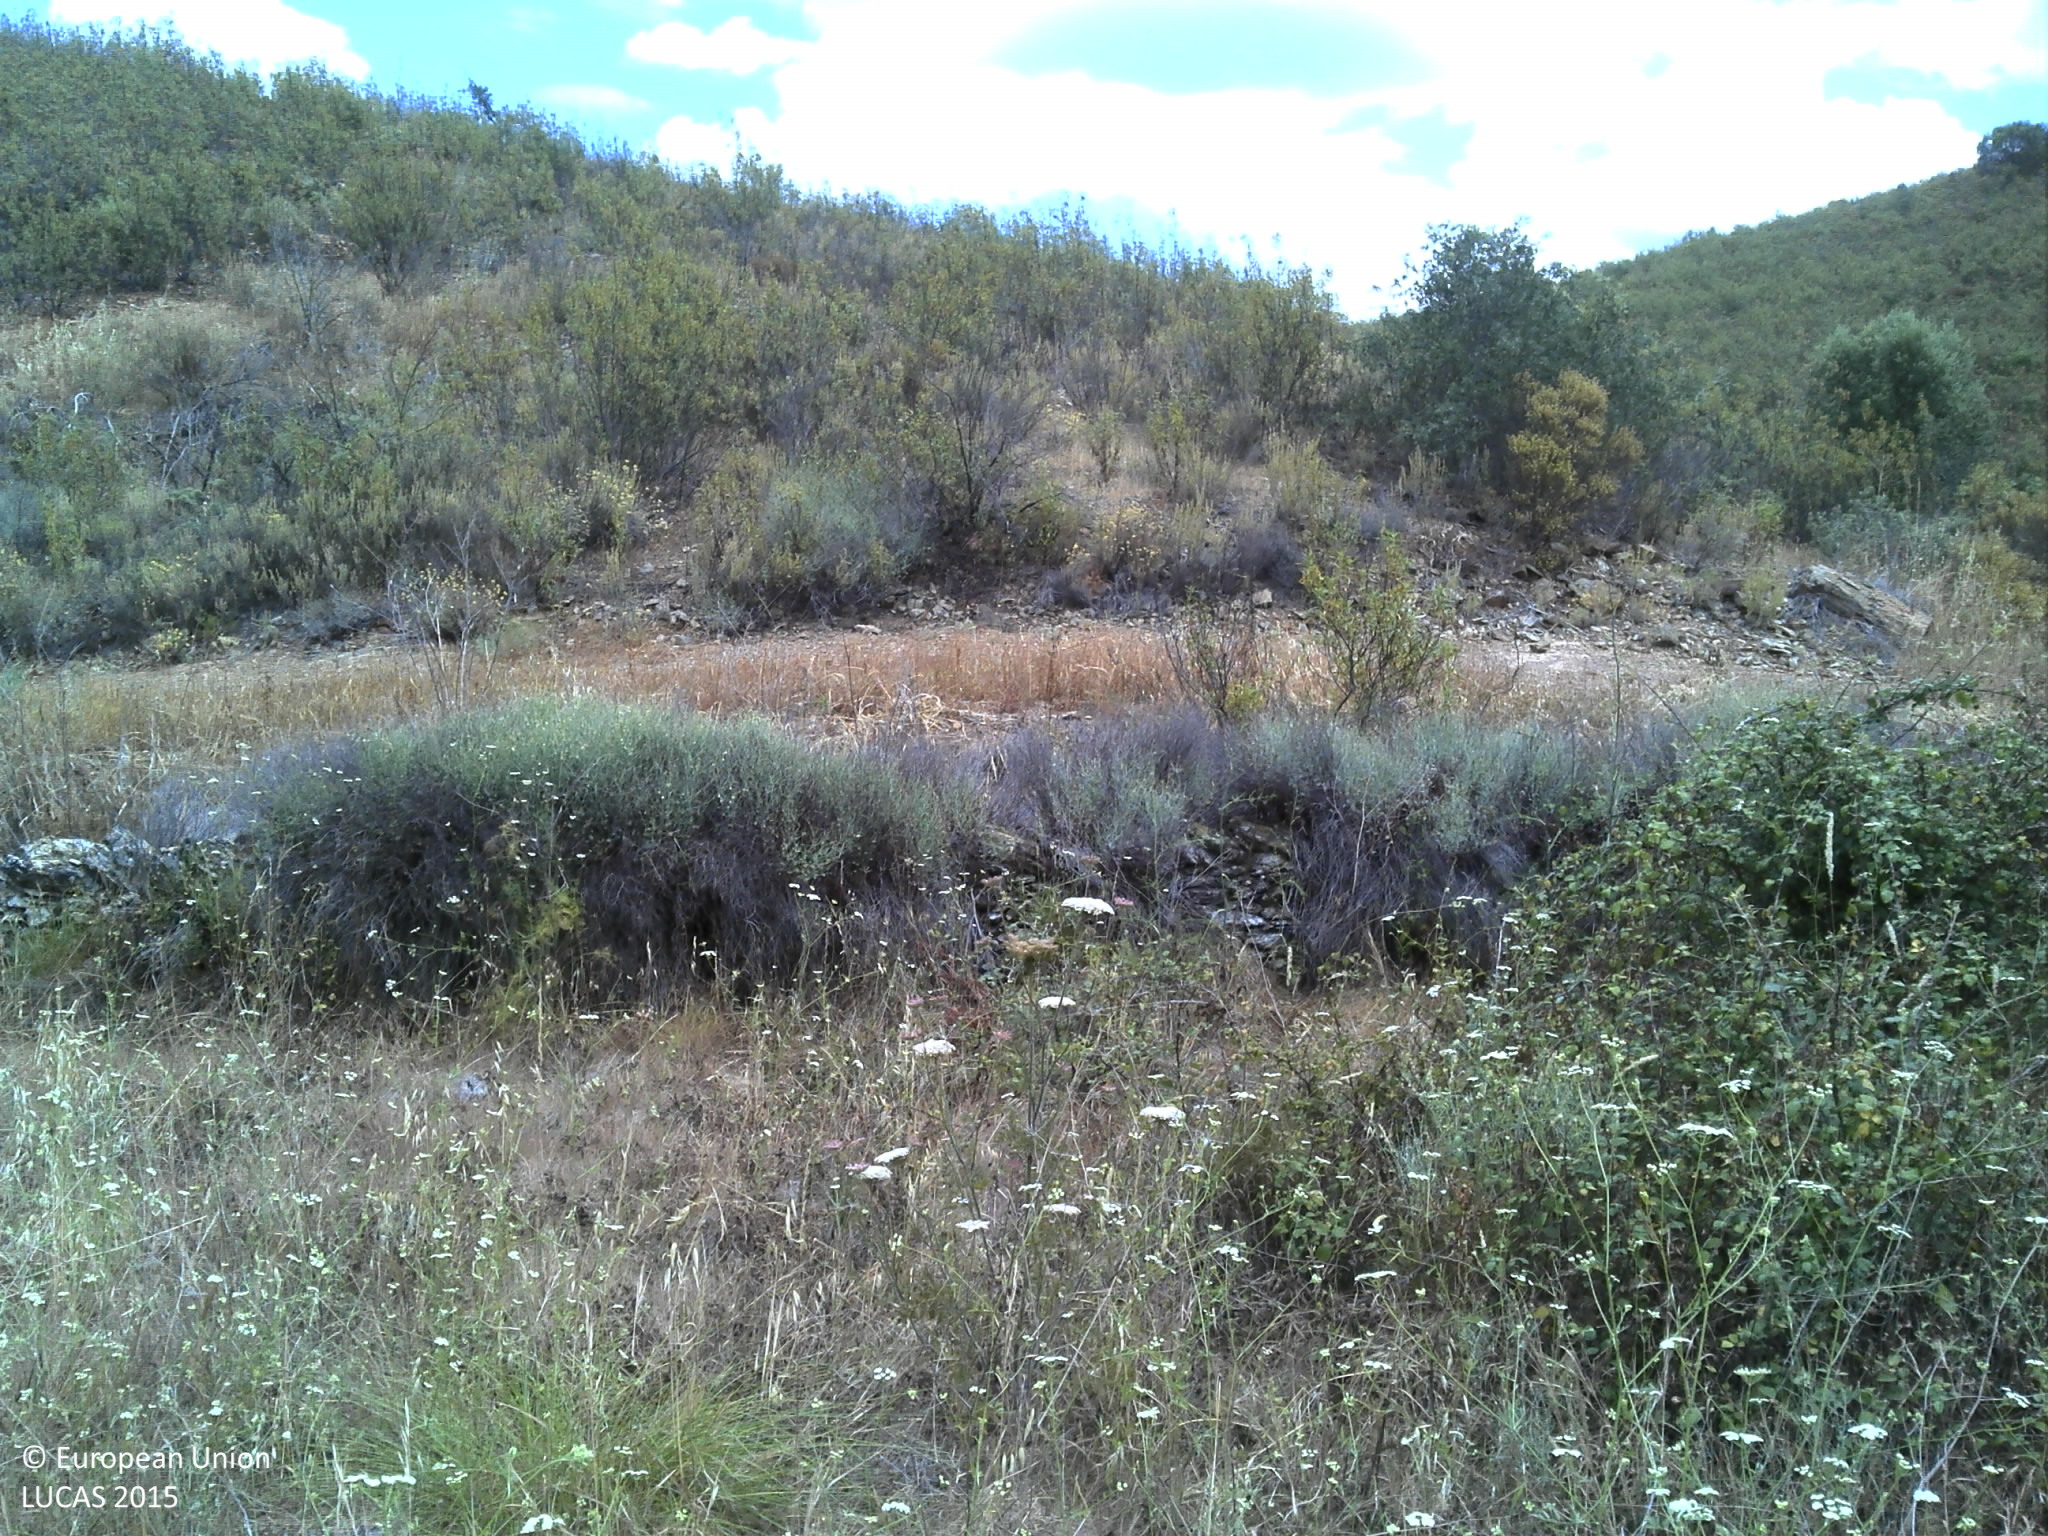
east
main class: Cropland
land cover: Olive groves
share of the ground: 25 - 50 %
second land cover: Shrubland without tree cover
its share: 50 - 75 %
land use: Agriculture (excluding fallow land and kitchen gardens)
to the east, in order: Olive groves; Shrubland without tree cover; Dry stone walls; Rivers and streams; Grass margins; Tracks; Shrubland without tree cover; Shrubland with sparse tree cover; Rivers and streams; Shrubland without tree cover; Tracks; Shrubland with sparse tree cover
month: June
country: PT
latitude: 37.3462
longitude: -7.8148
